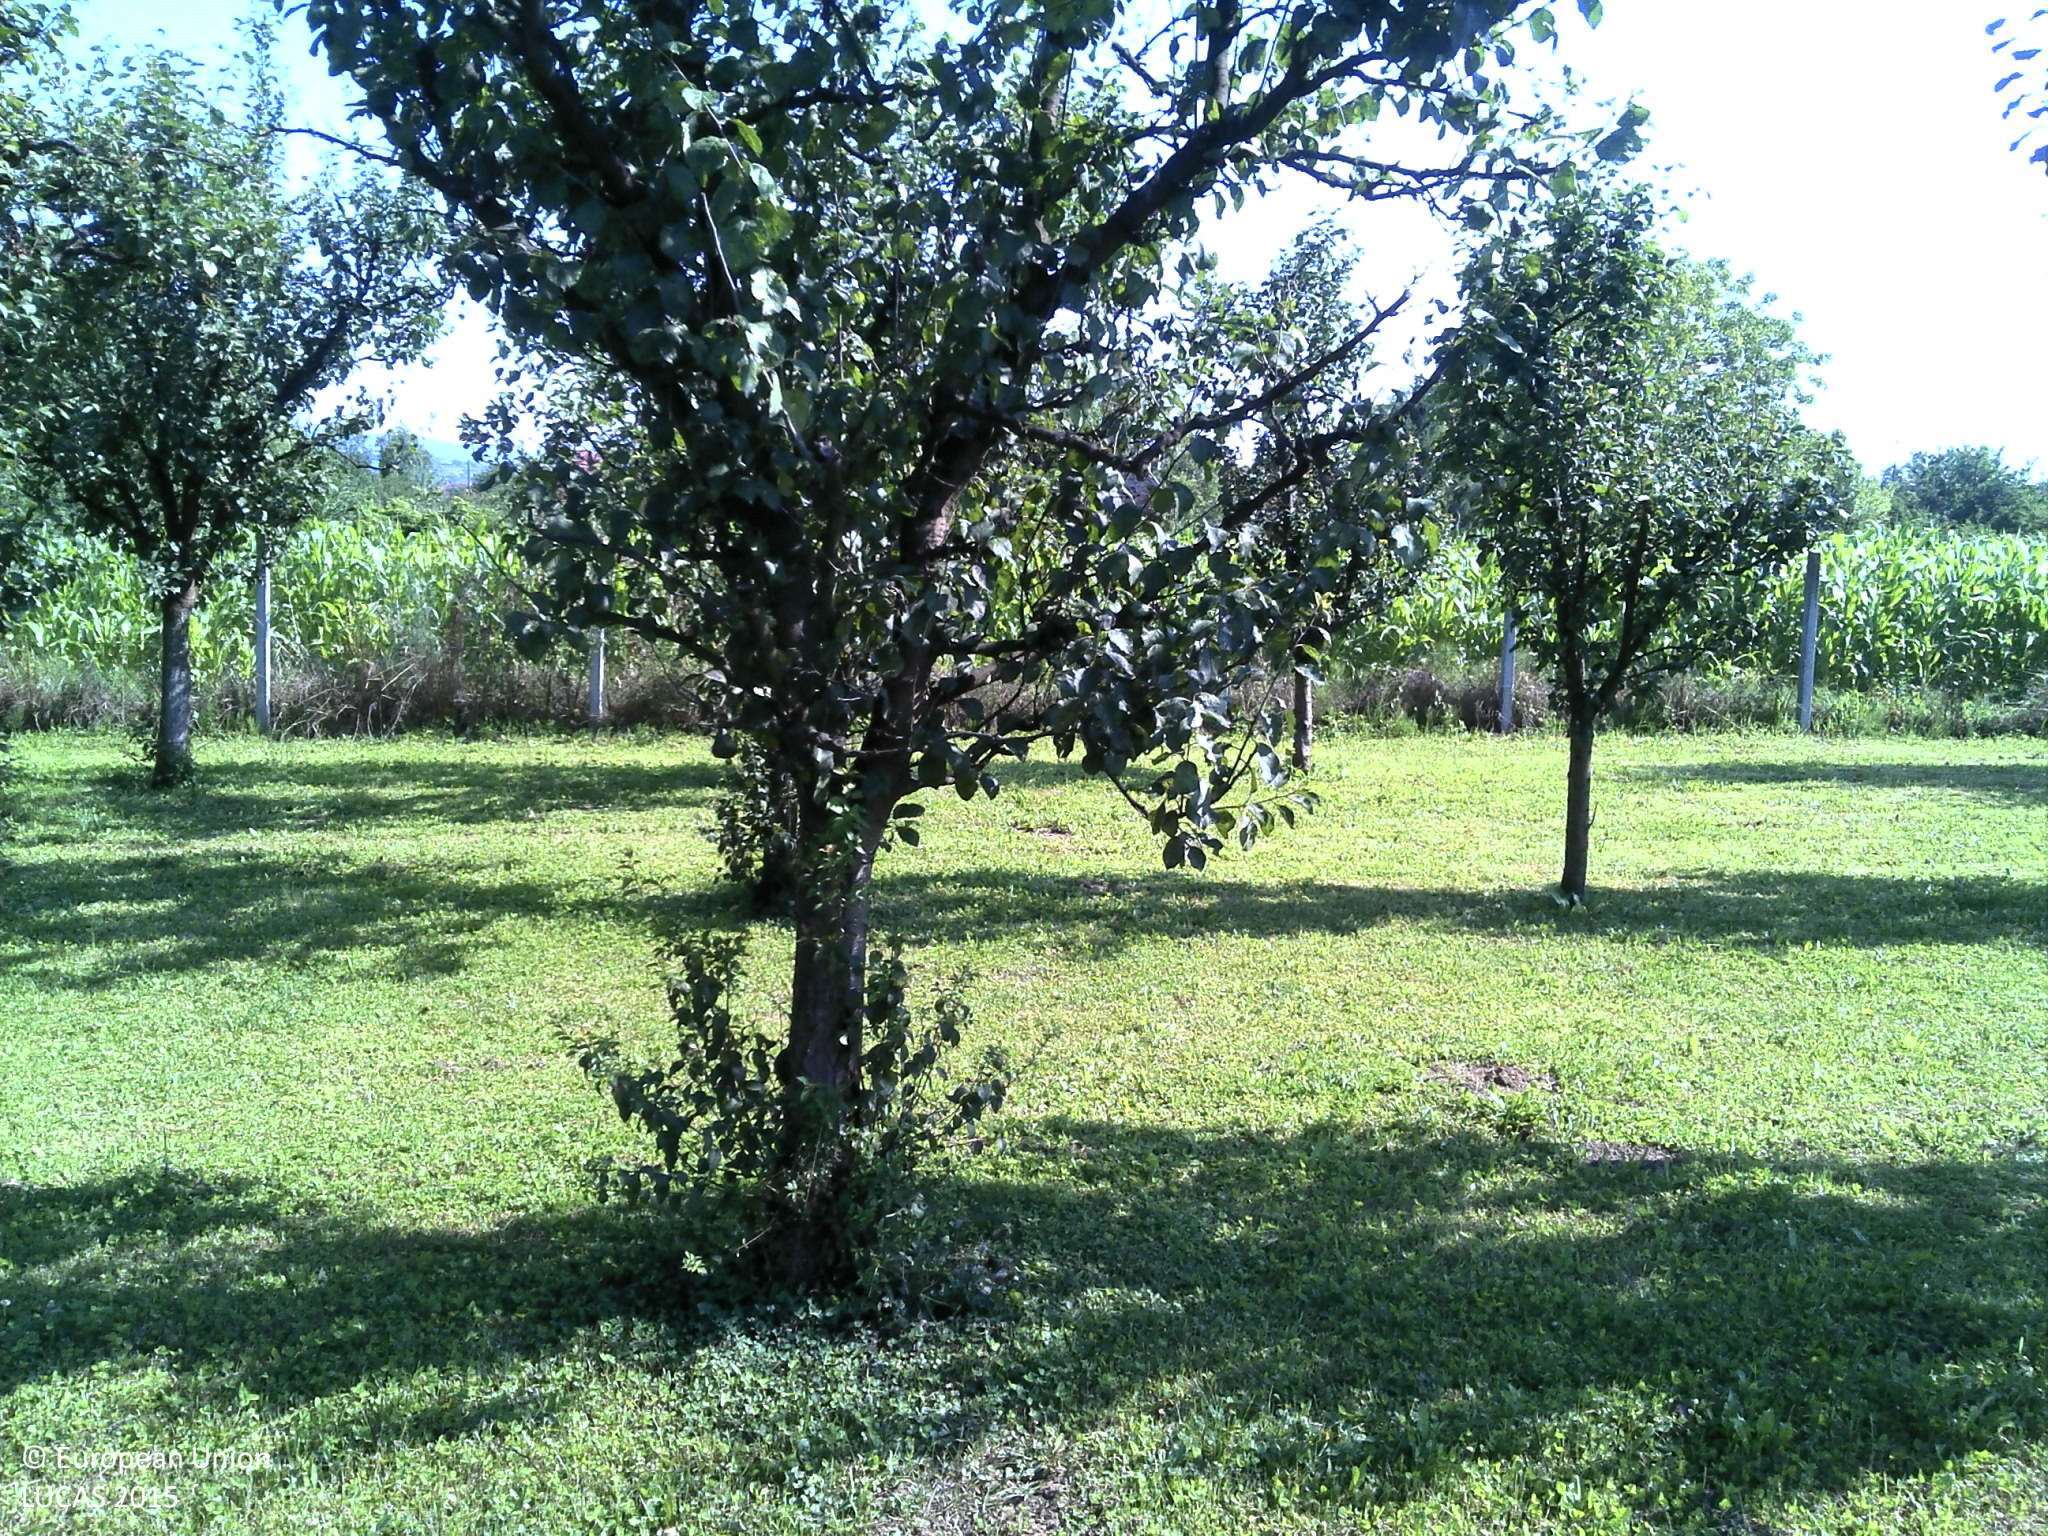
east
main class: Cropland
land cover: Nurseries
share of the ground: 10 - 25 %
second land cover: Spontaneously vegetated surfaces
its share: > 75 %
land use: Agriculture (excluding fallow land and kitchen gardens)
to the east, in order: Nurseries; Spontaneously vegetated surfaces; Fences; Spontaneously vegetated surfaces; Artificial constructions in urban areas; Permanent crops (only in case pi); Arable land (only in case pi)
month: June
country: HR
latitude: 45.2462
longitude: 17.3768
